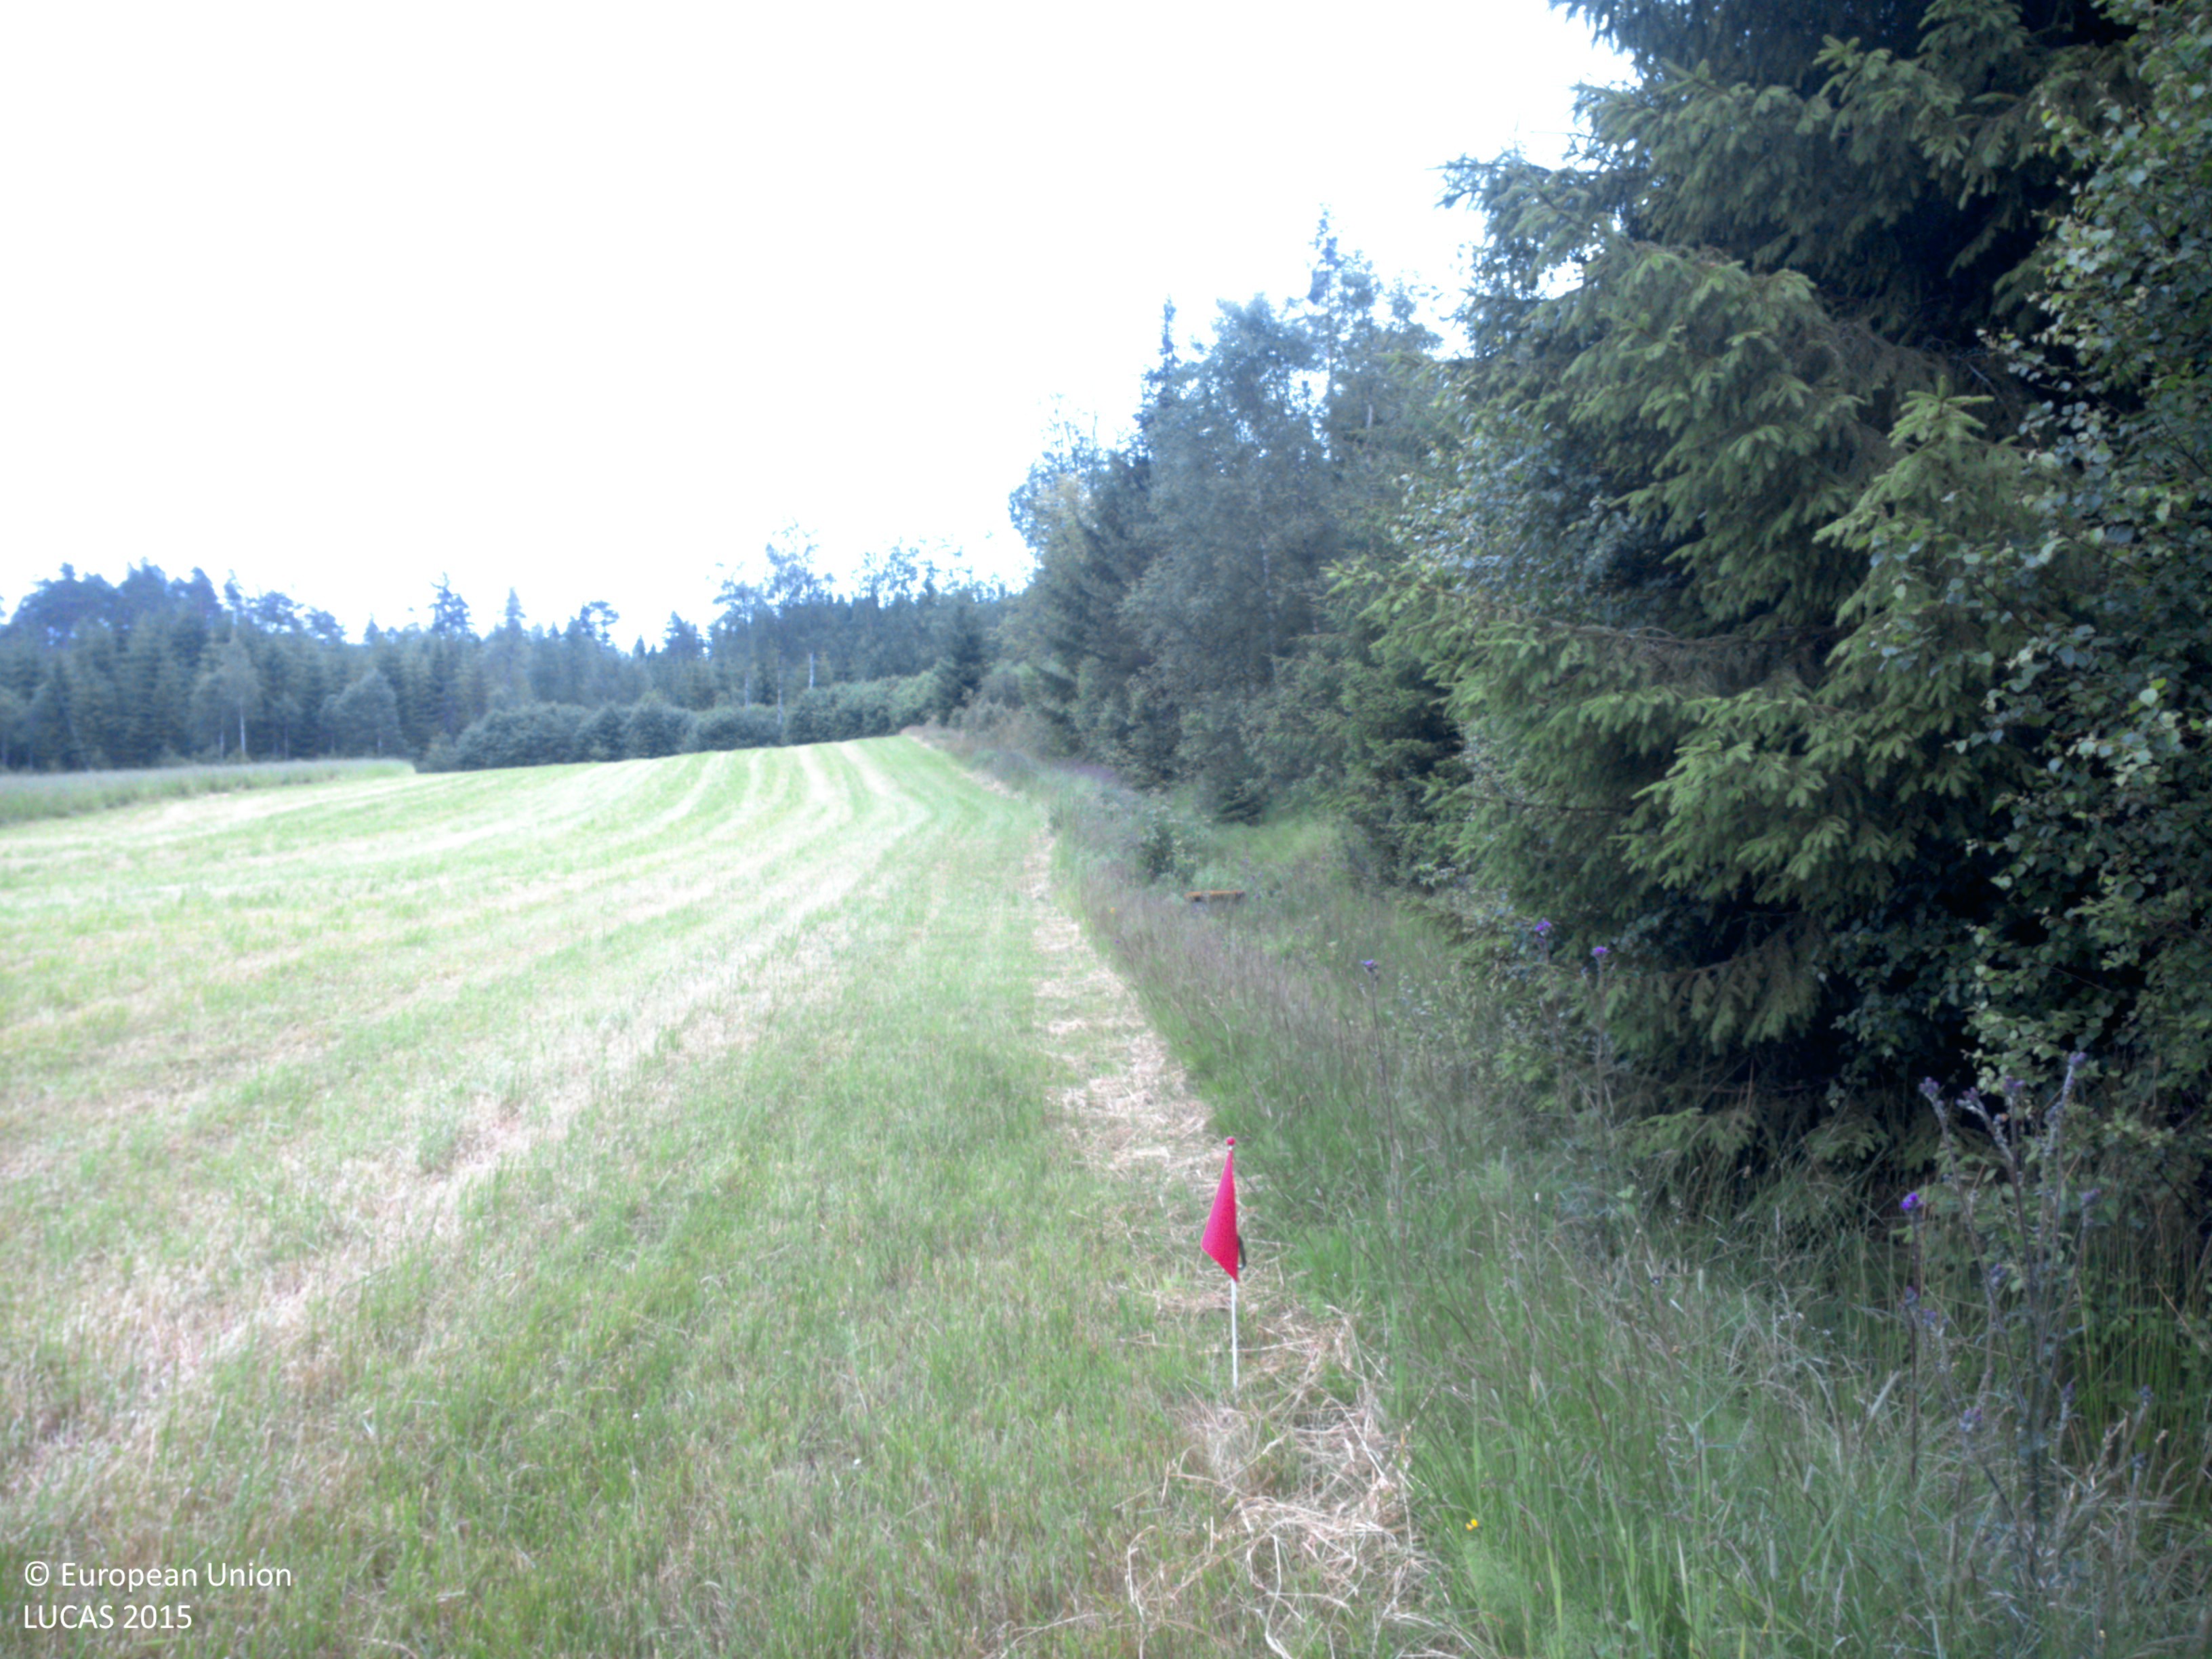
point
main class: Cropland
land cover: Mixed cereals for fodder
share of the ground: > 75 %
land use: Agriculture (excluding fallow land and kitchen gardens)
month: July
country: SE
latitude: 58.6707
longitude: 12.1164
